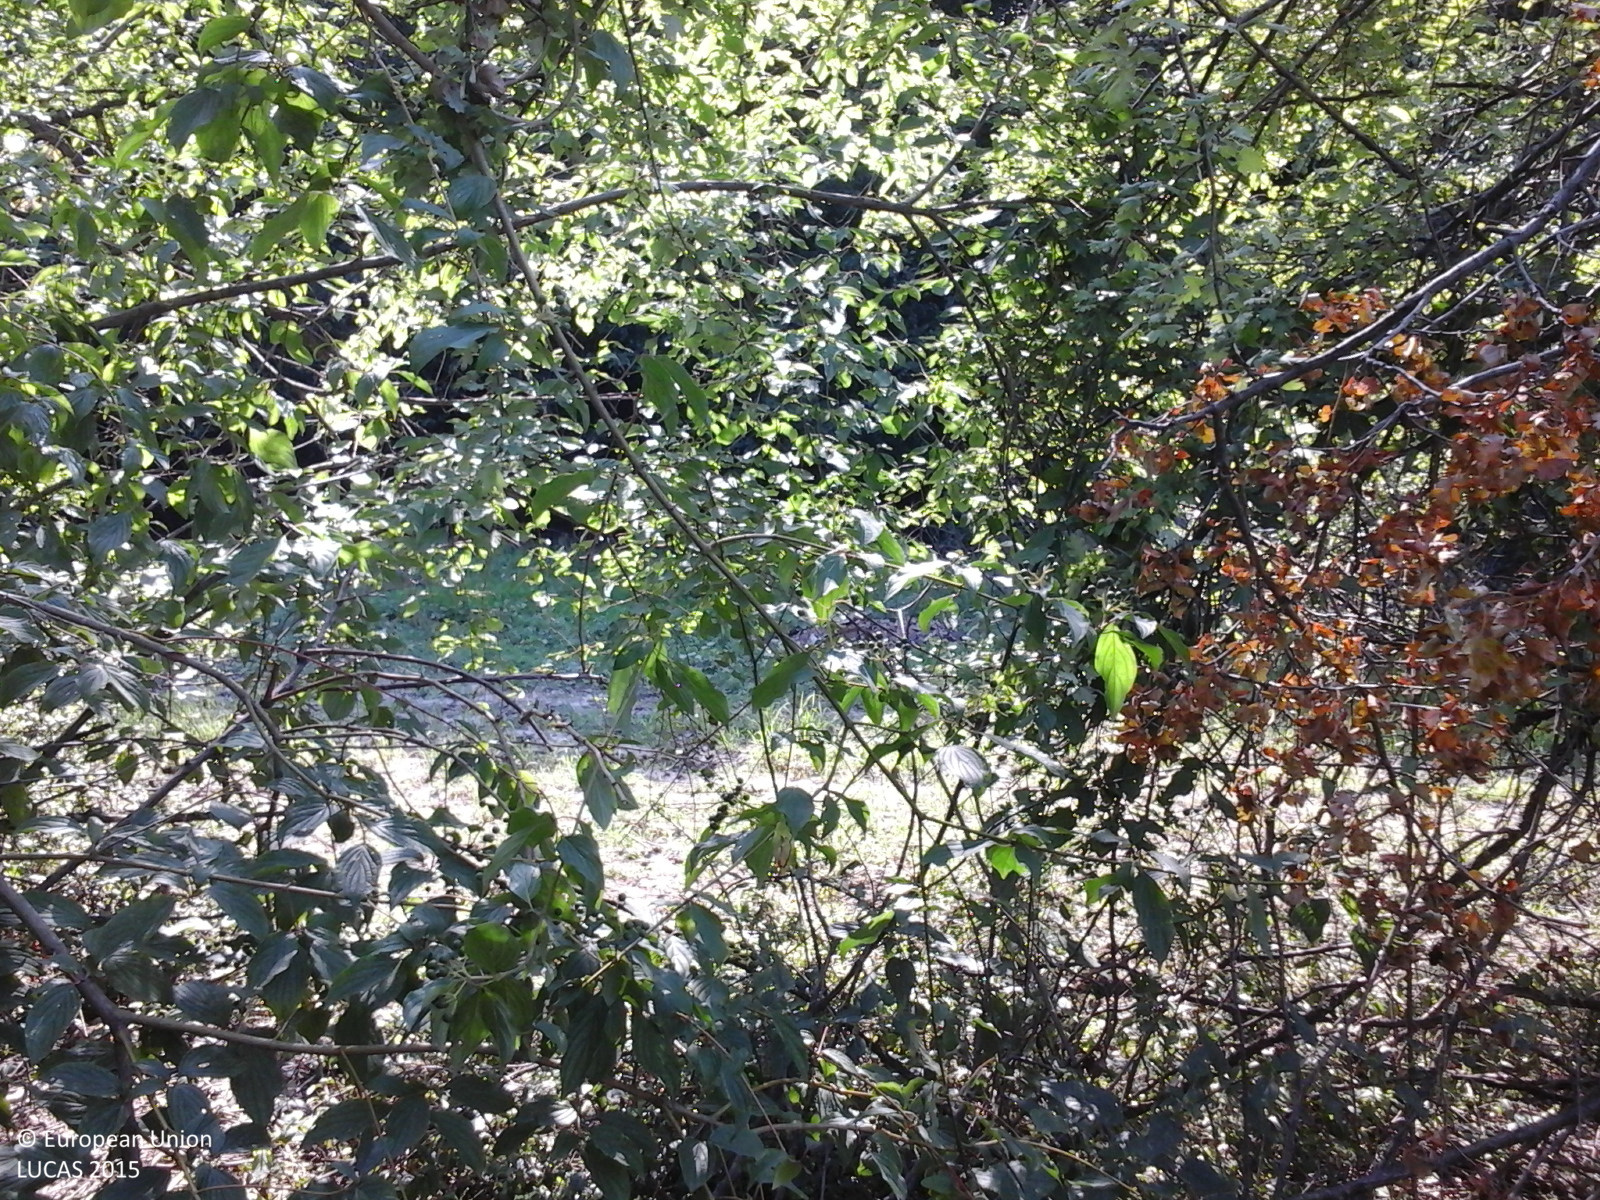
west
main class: Woodland
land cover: Broadleaved woodland
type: floodplain forest
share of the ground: > 75 %
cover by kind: broadleaved forest trees 90 %, shrubs 5 %, herbaceous plants 5 %
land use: Forestry
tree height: < 5 m
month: July
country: RO
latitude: 44.7304
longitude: 24.7891
